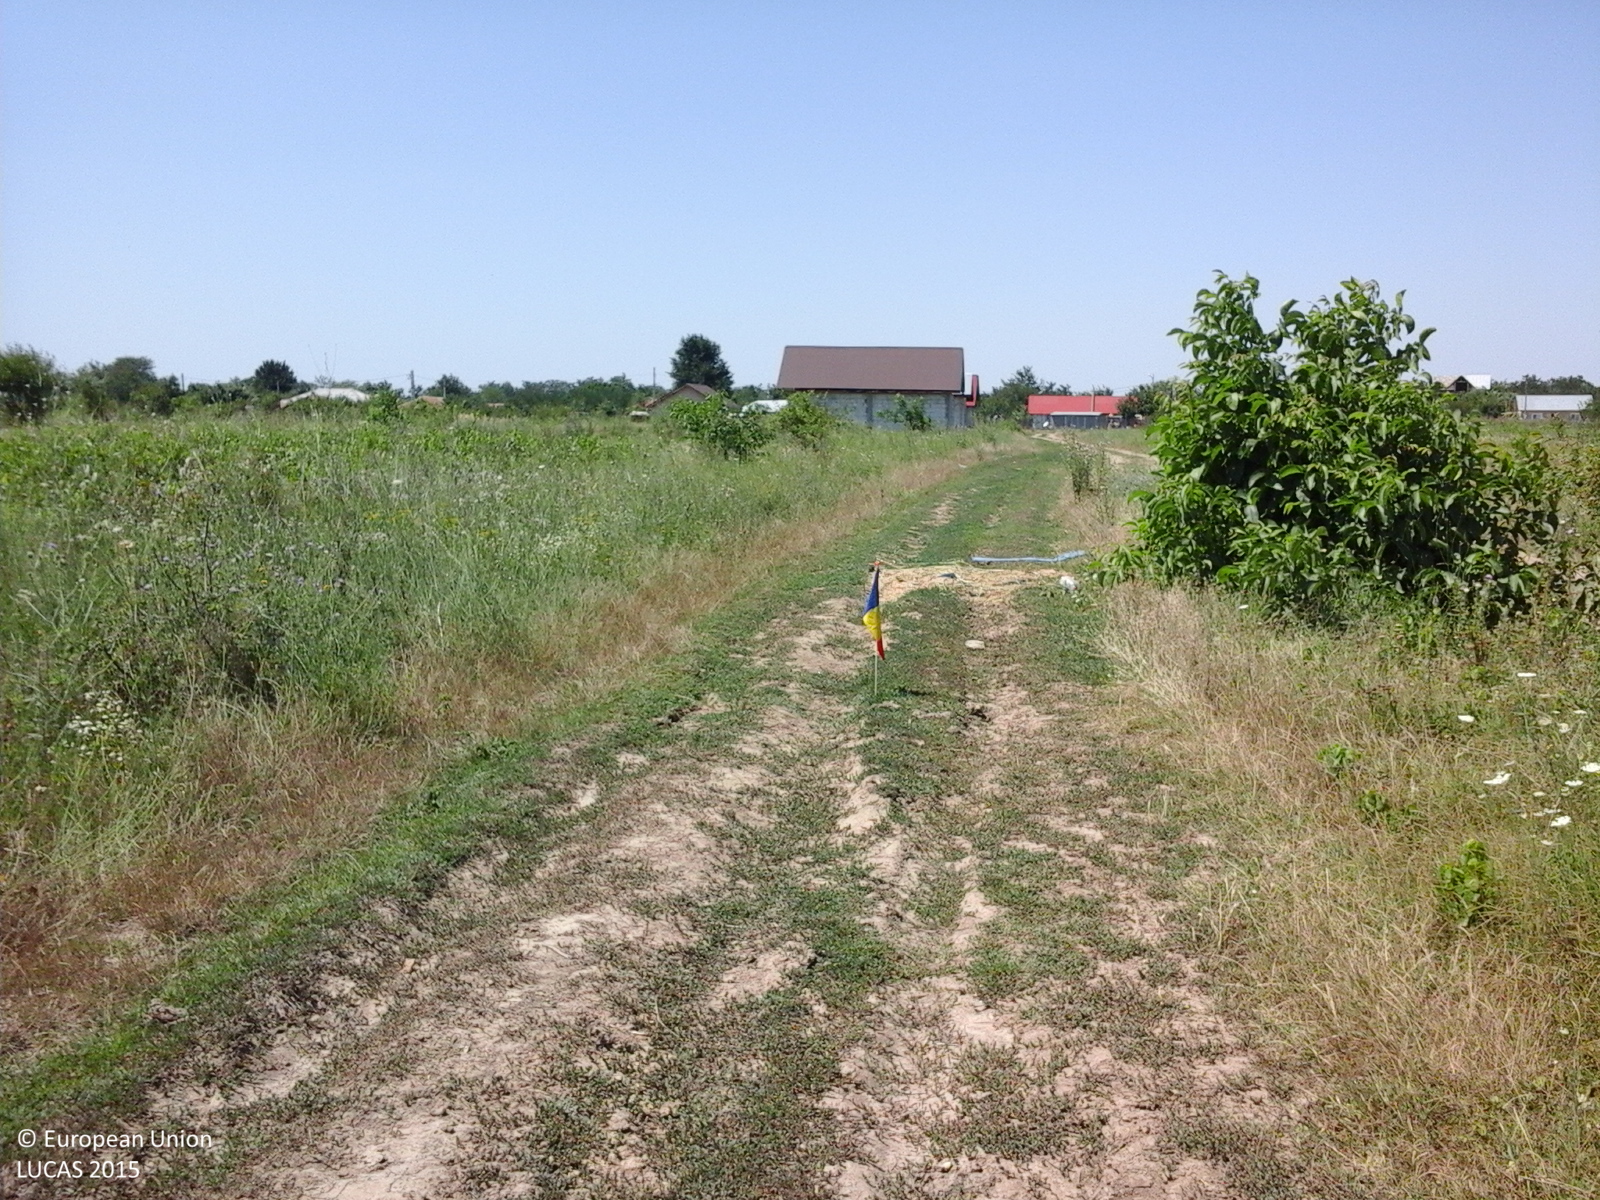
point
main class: Artificial land
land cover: Non built-up linear features
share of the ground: > 75 %
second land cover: Spontaneously vegetated surfaces
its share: 50 - 75 %
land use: Agriculture (excluding fallow land and kitchen gardens)
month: July
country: RO
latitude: 44.3174
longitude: 26.4236
